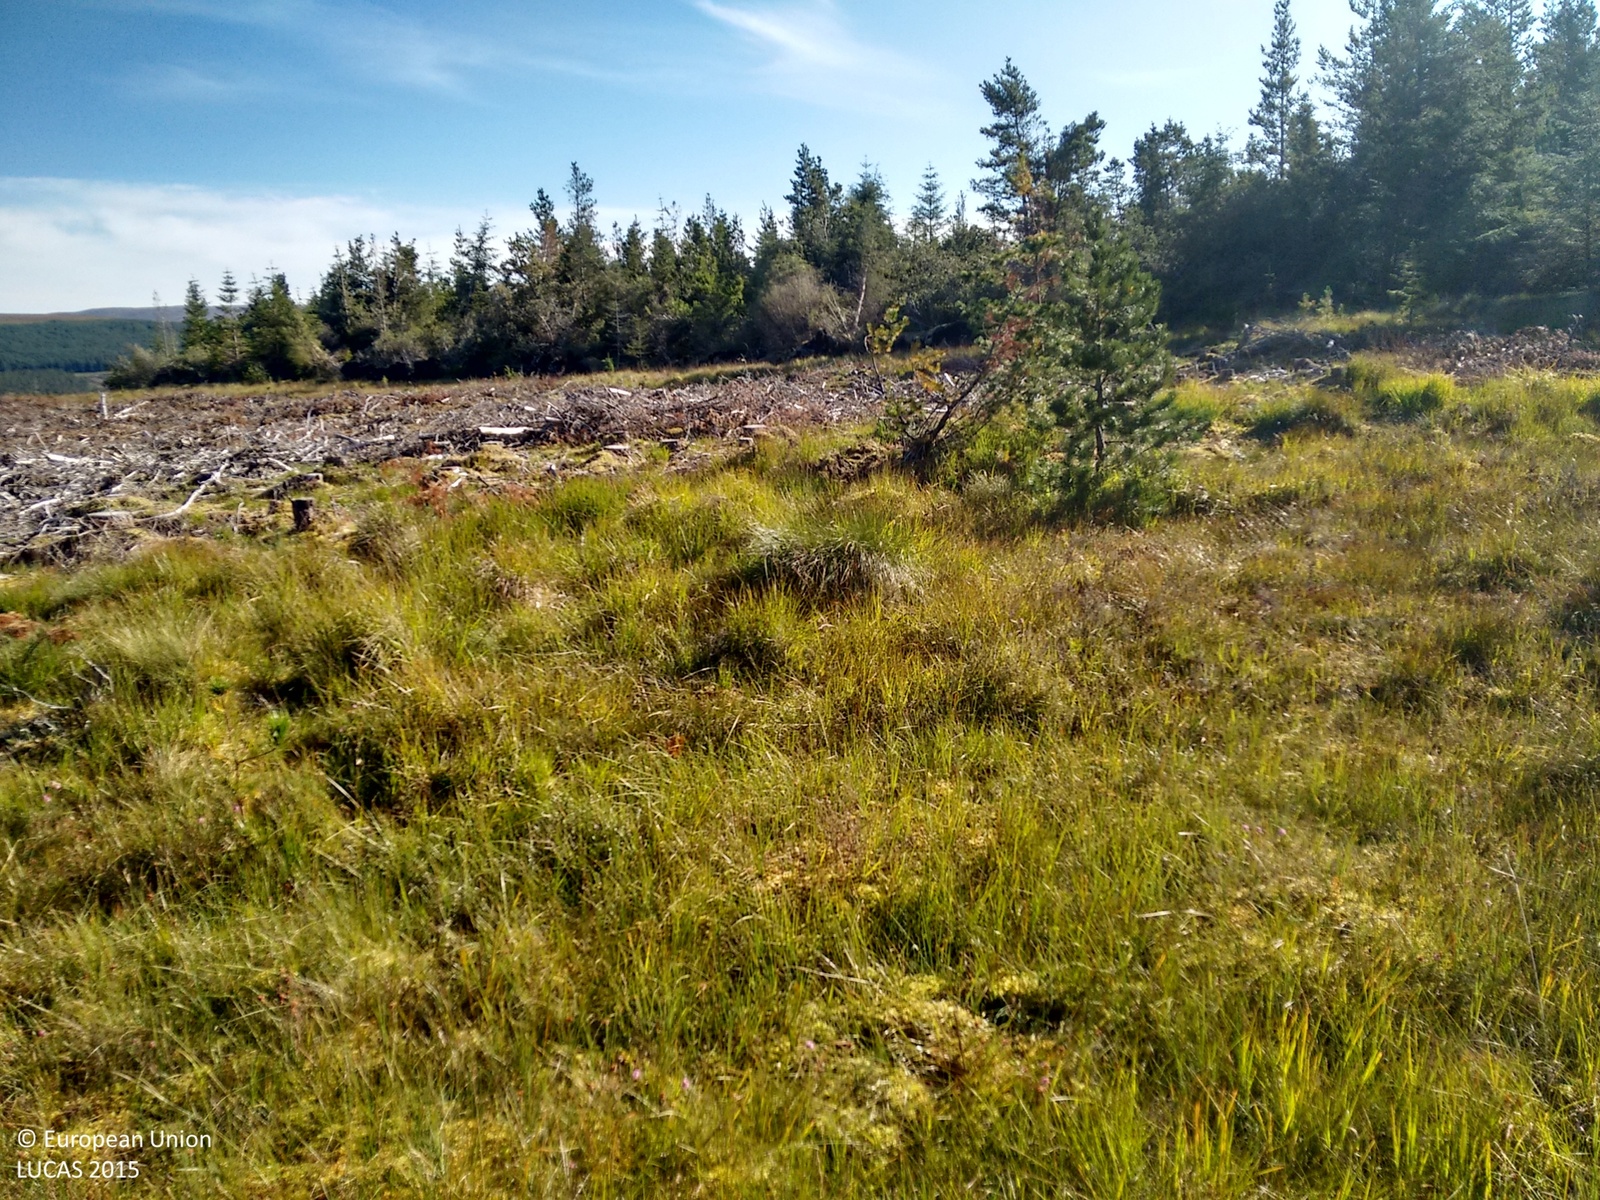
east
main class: Grassland
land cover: Grassland without tree/shrub cover
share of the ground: > 75 %
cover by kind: herbaceous plants 90 %, lichens and mosses 10 %
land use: Forestry
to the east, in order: Grassland without tree/shrub cover; Spontaneously vegetated surfaces; Grassland without tree/shrub cover; Spruce dominated coniferous woodland
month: September
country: GB
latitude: 58.0127
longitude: -4.8377
